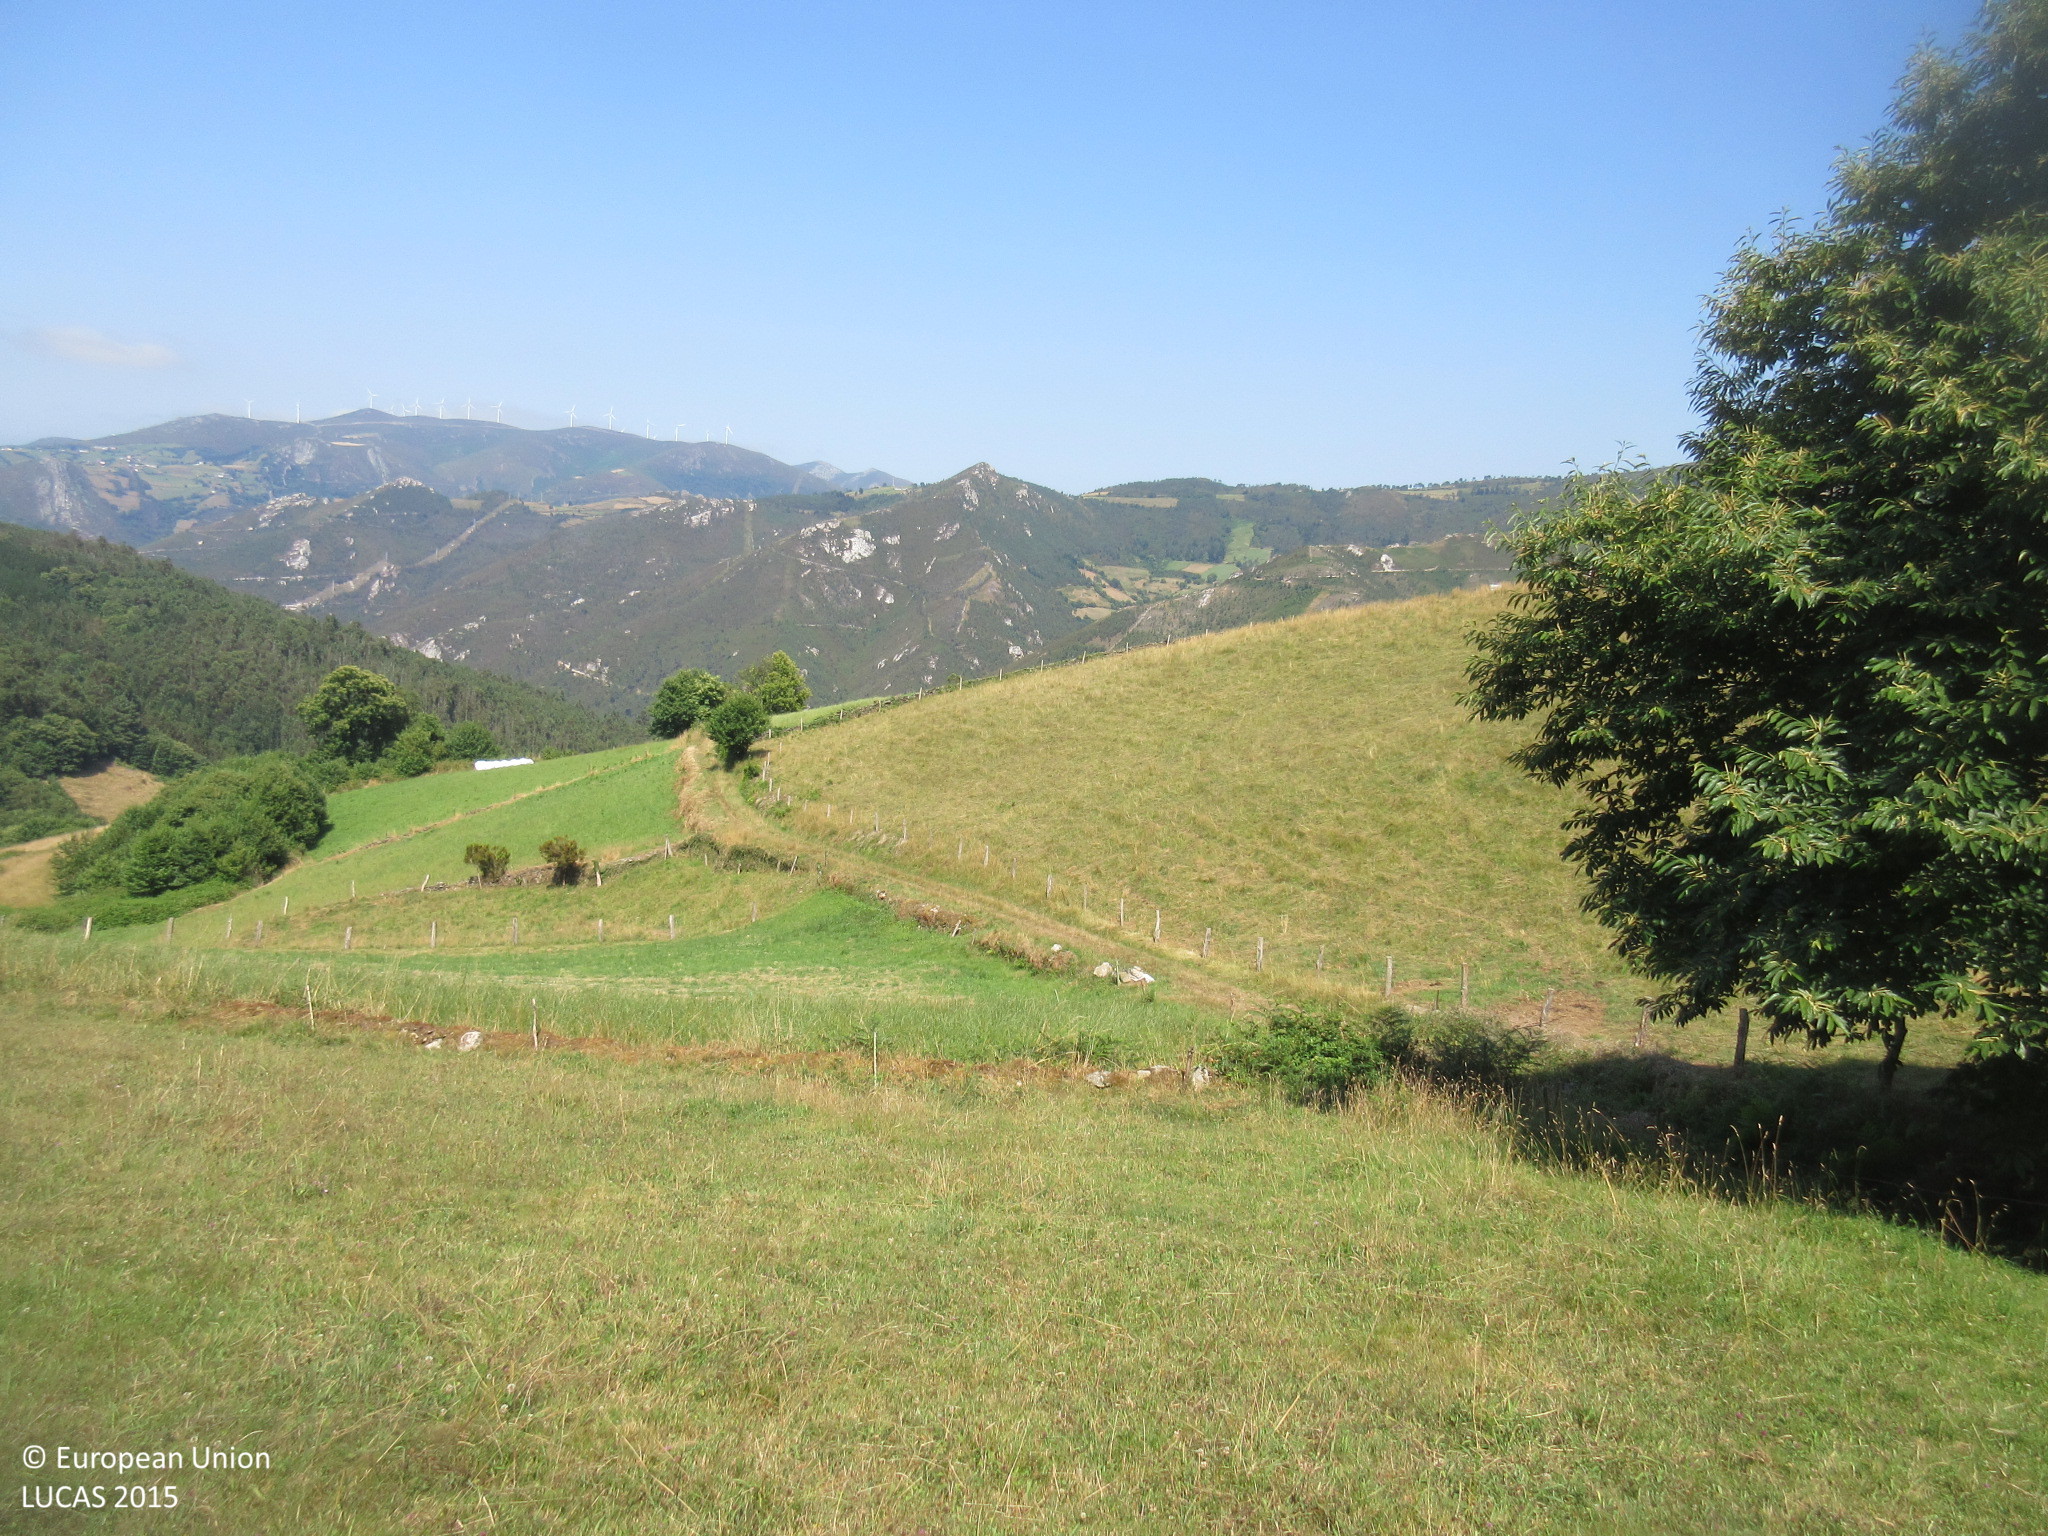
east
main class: Grassland
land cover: Grassland without tree/shrub cover
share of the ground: > 75 %
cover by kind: herbaceous plants 100 %
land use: Agriculture (excluding fallow land and kitchen gardens)
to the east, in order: Grassland without tree/shrub cover; Fences; Tracks; Grassland without tree/shrub cover; Fences; Grassland without tree/shrub cover; Dry stone walls; Fences; Grassland without tree/shrub cover; Tracks; Fences; Grassland without tree/shrub cover; Fences; Dry stone walls; Tracks; Broadleaved woodland
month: July
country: ES
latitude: 43.3841
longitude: -6.7364
